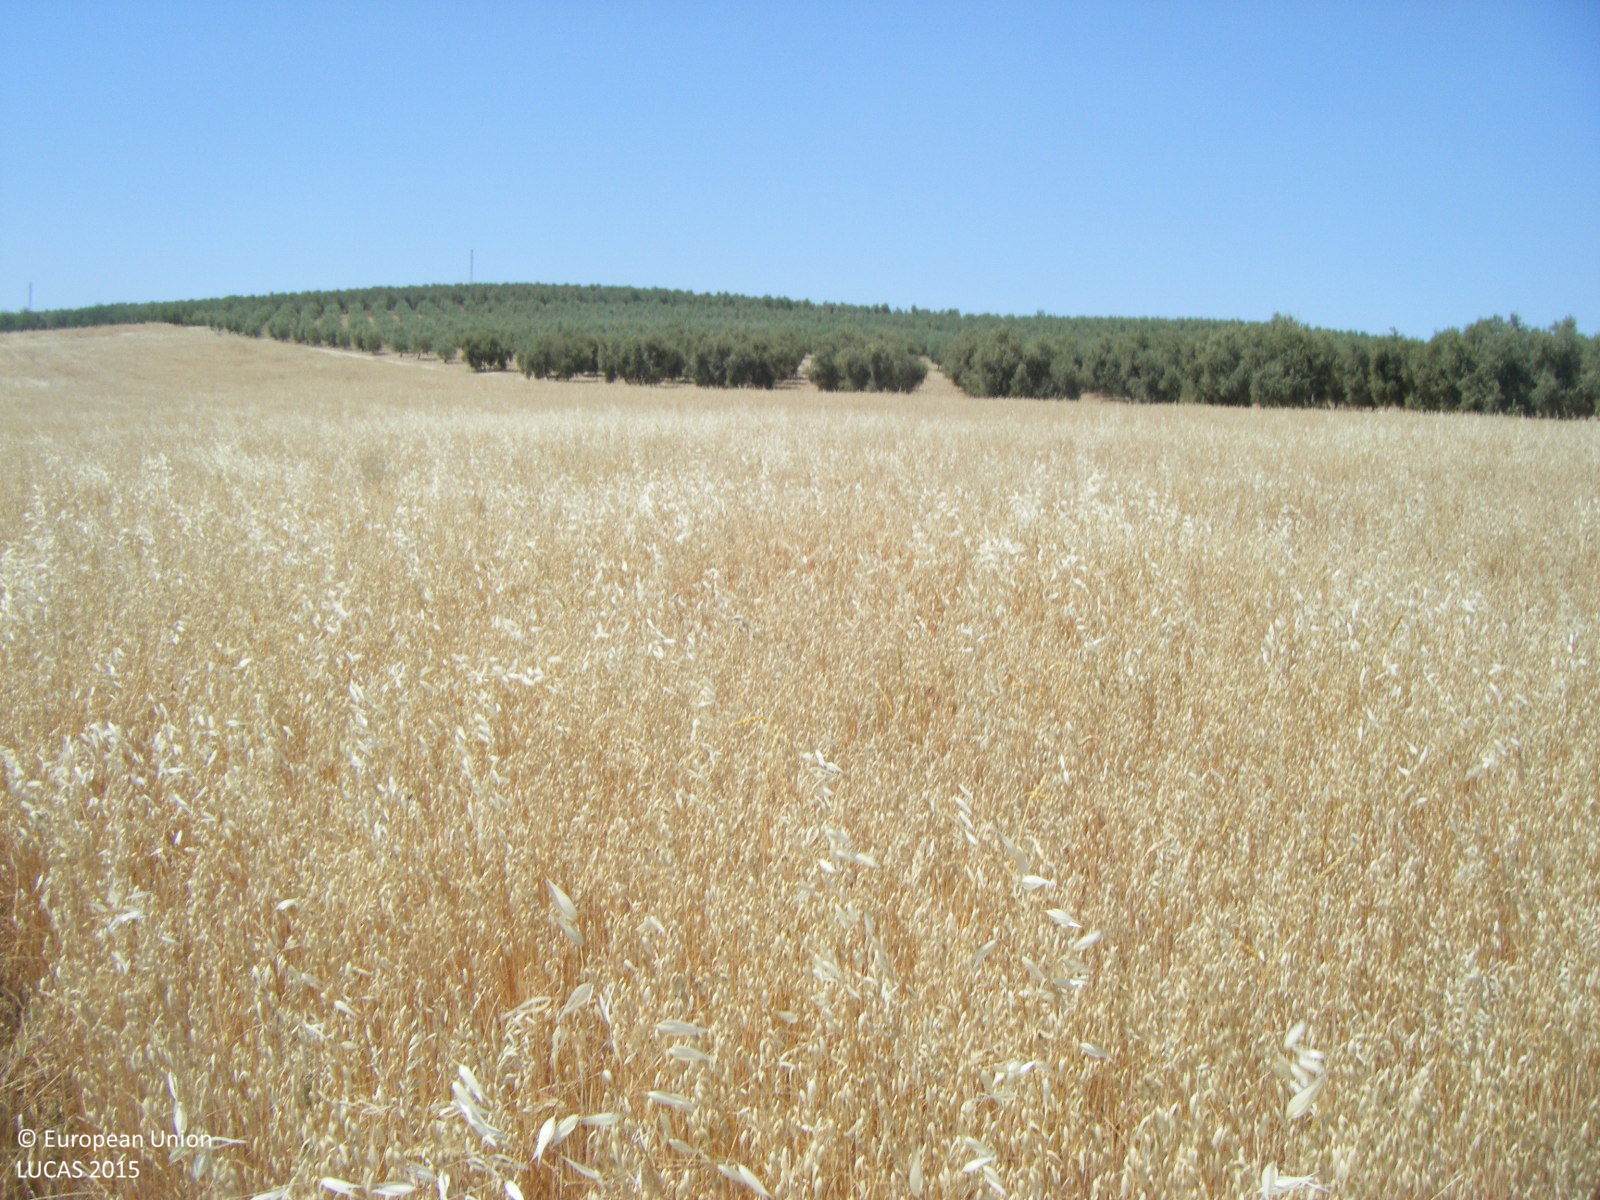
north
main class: Cropland
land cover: Oats
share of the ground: > 75 %
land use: Agriculture (excluding fallow land and kitchen gardens)
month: May
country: ES
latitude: 37.2000
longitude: -4.4993
